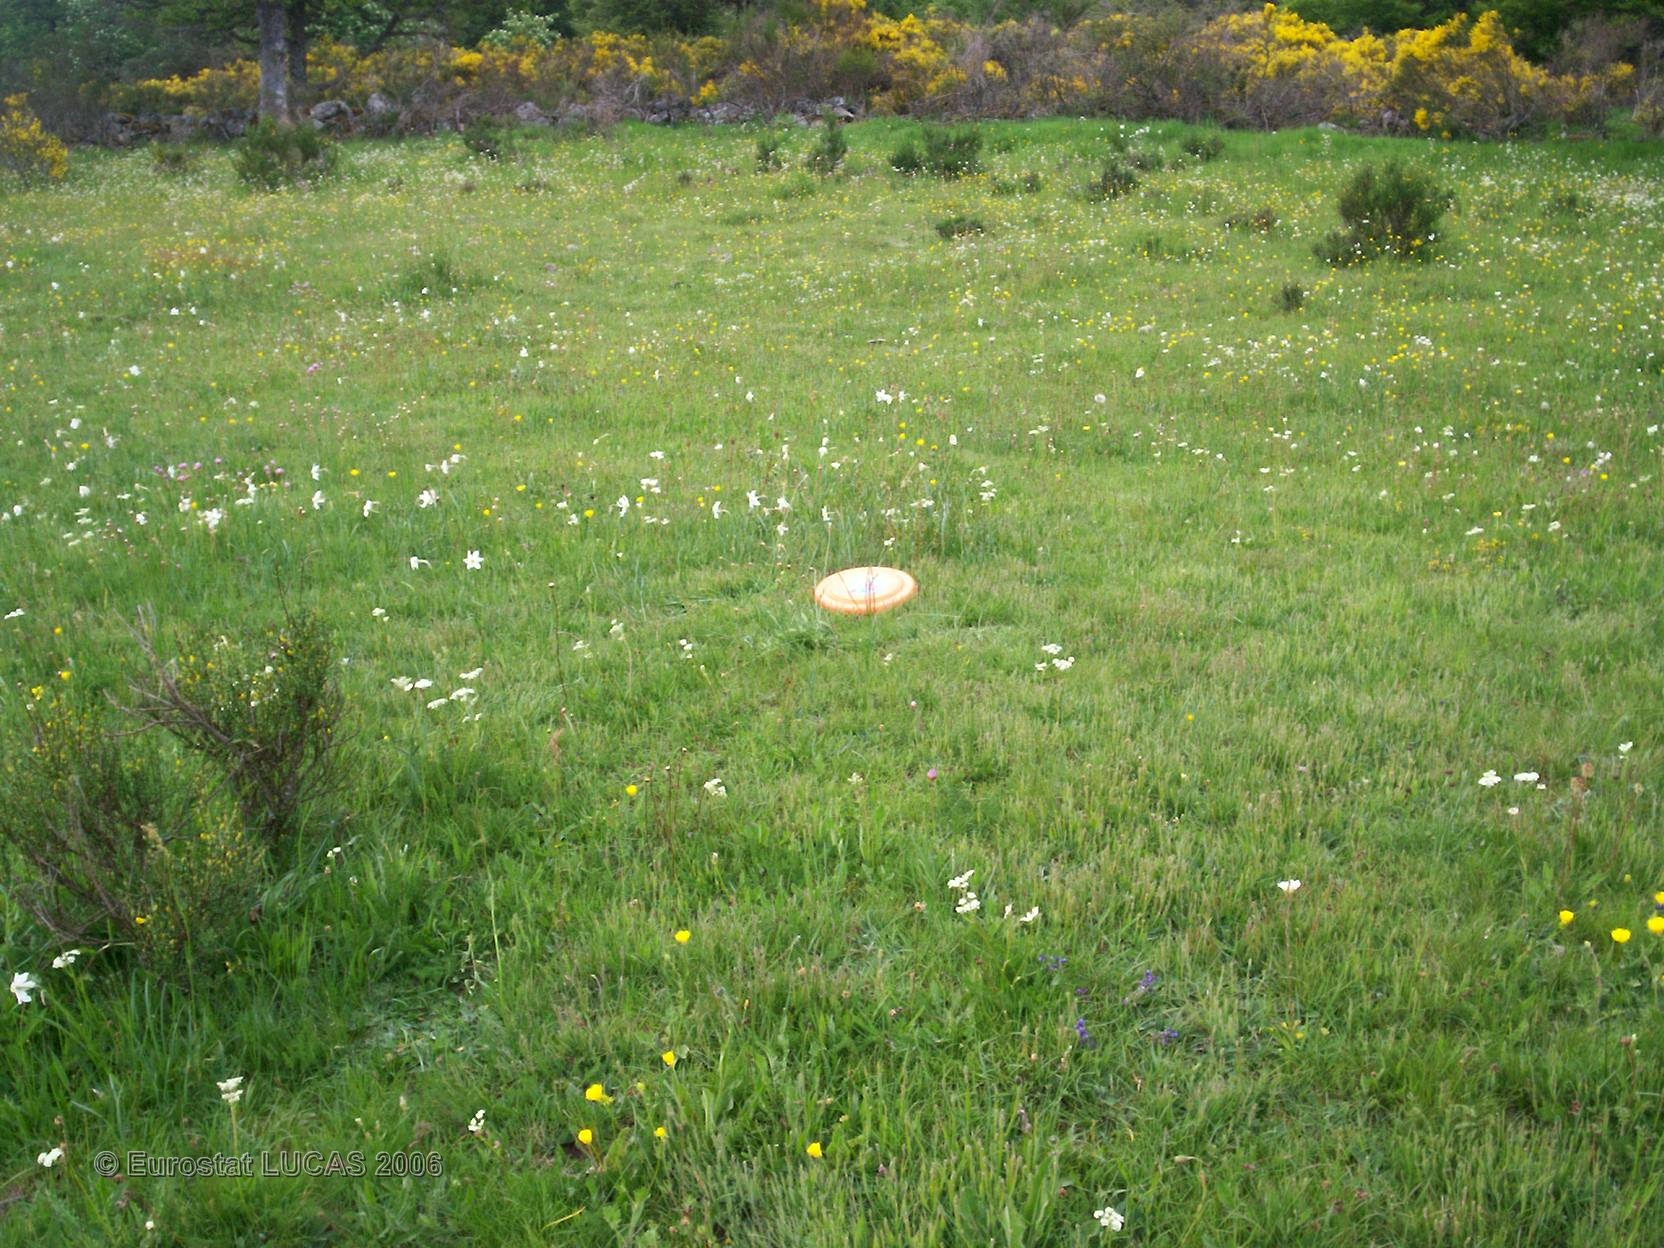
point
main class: Grassland
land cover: Grassland without tree/shrub cover
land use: Agriculture (excluding fallow land and kitchen gardens)
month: May
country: FR
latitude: 44.6295
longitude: 3.4122
